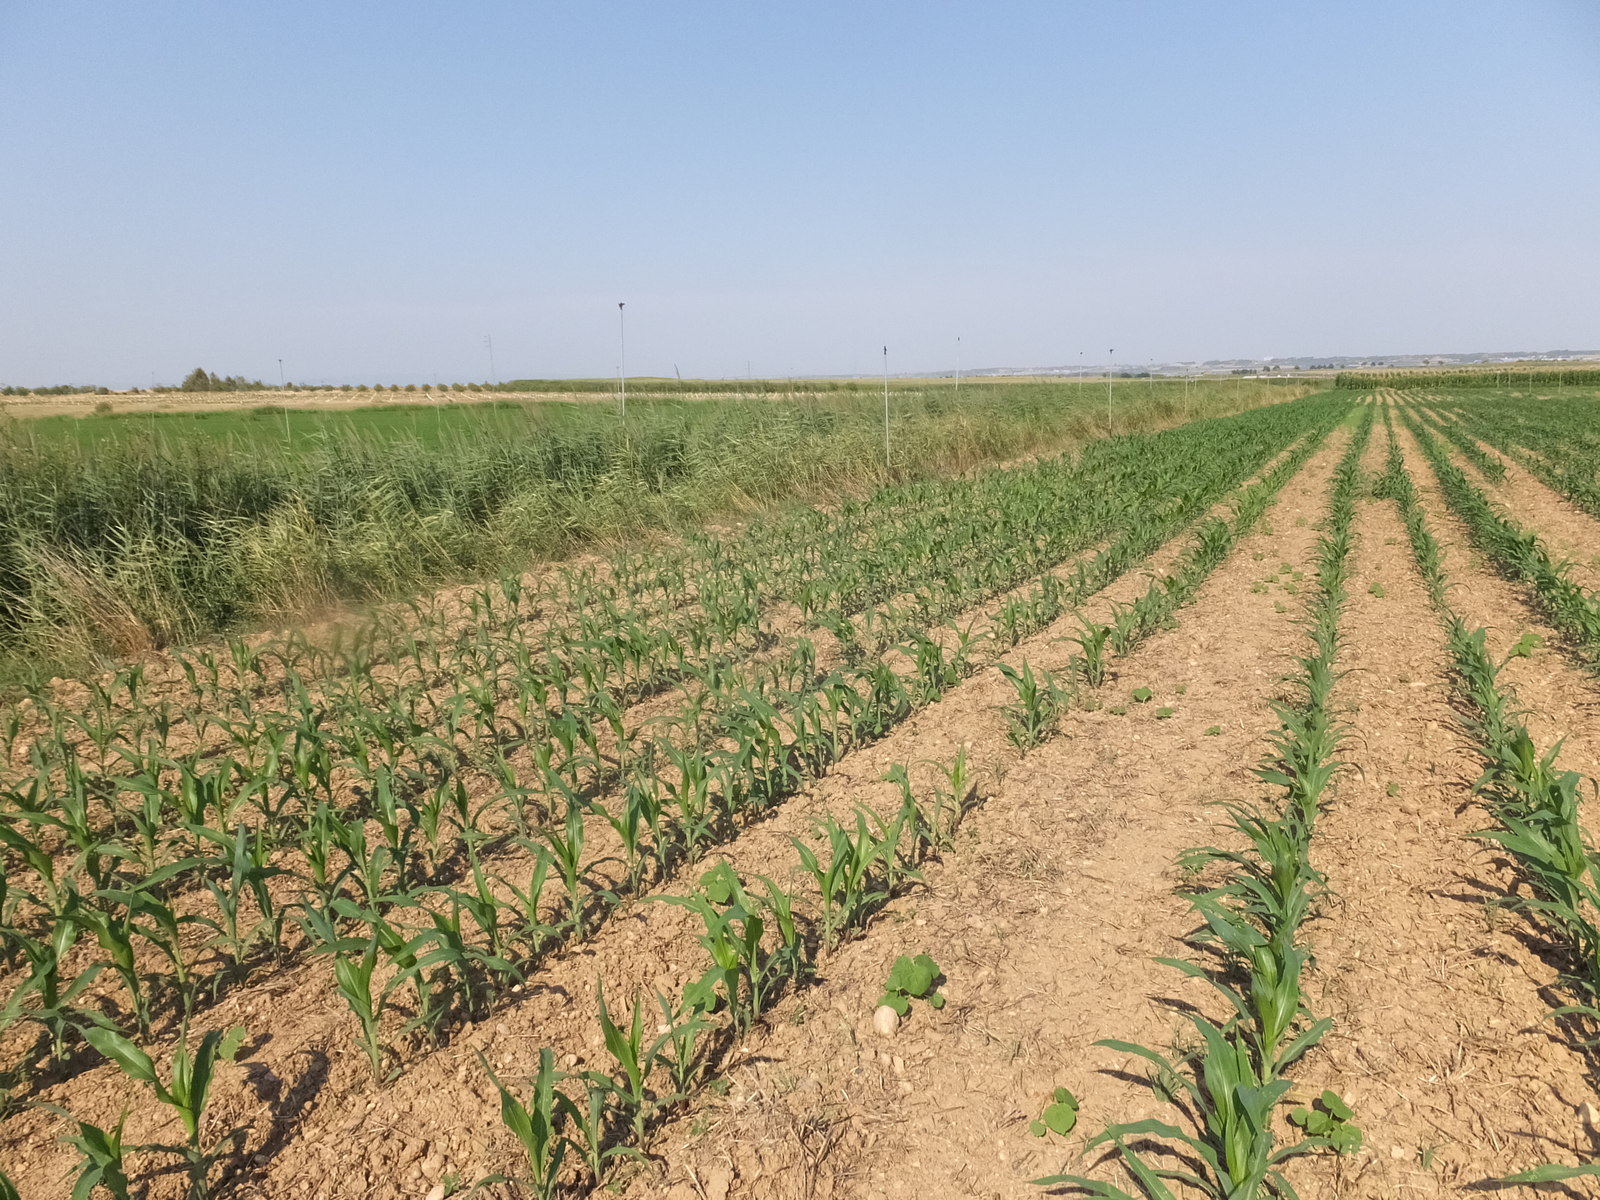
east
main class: Cropland
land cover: Maize
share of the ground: 10 - 25 %
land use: Agriculture (excluding fallow land and kitchen gardens)
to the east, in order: Maize; Grass margins; Ditches and canals; Grass margins; Maize; Grass margins; Ditches and canals; Grass margins; Maize
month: July
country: ES
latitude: 41.7157
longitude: 0.3097
